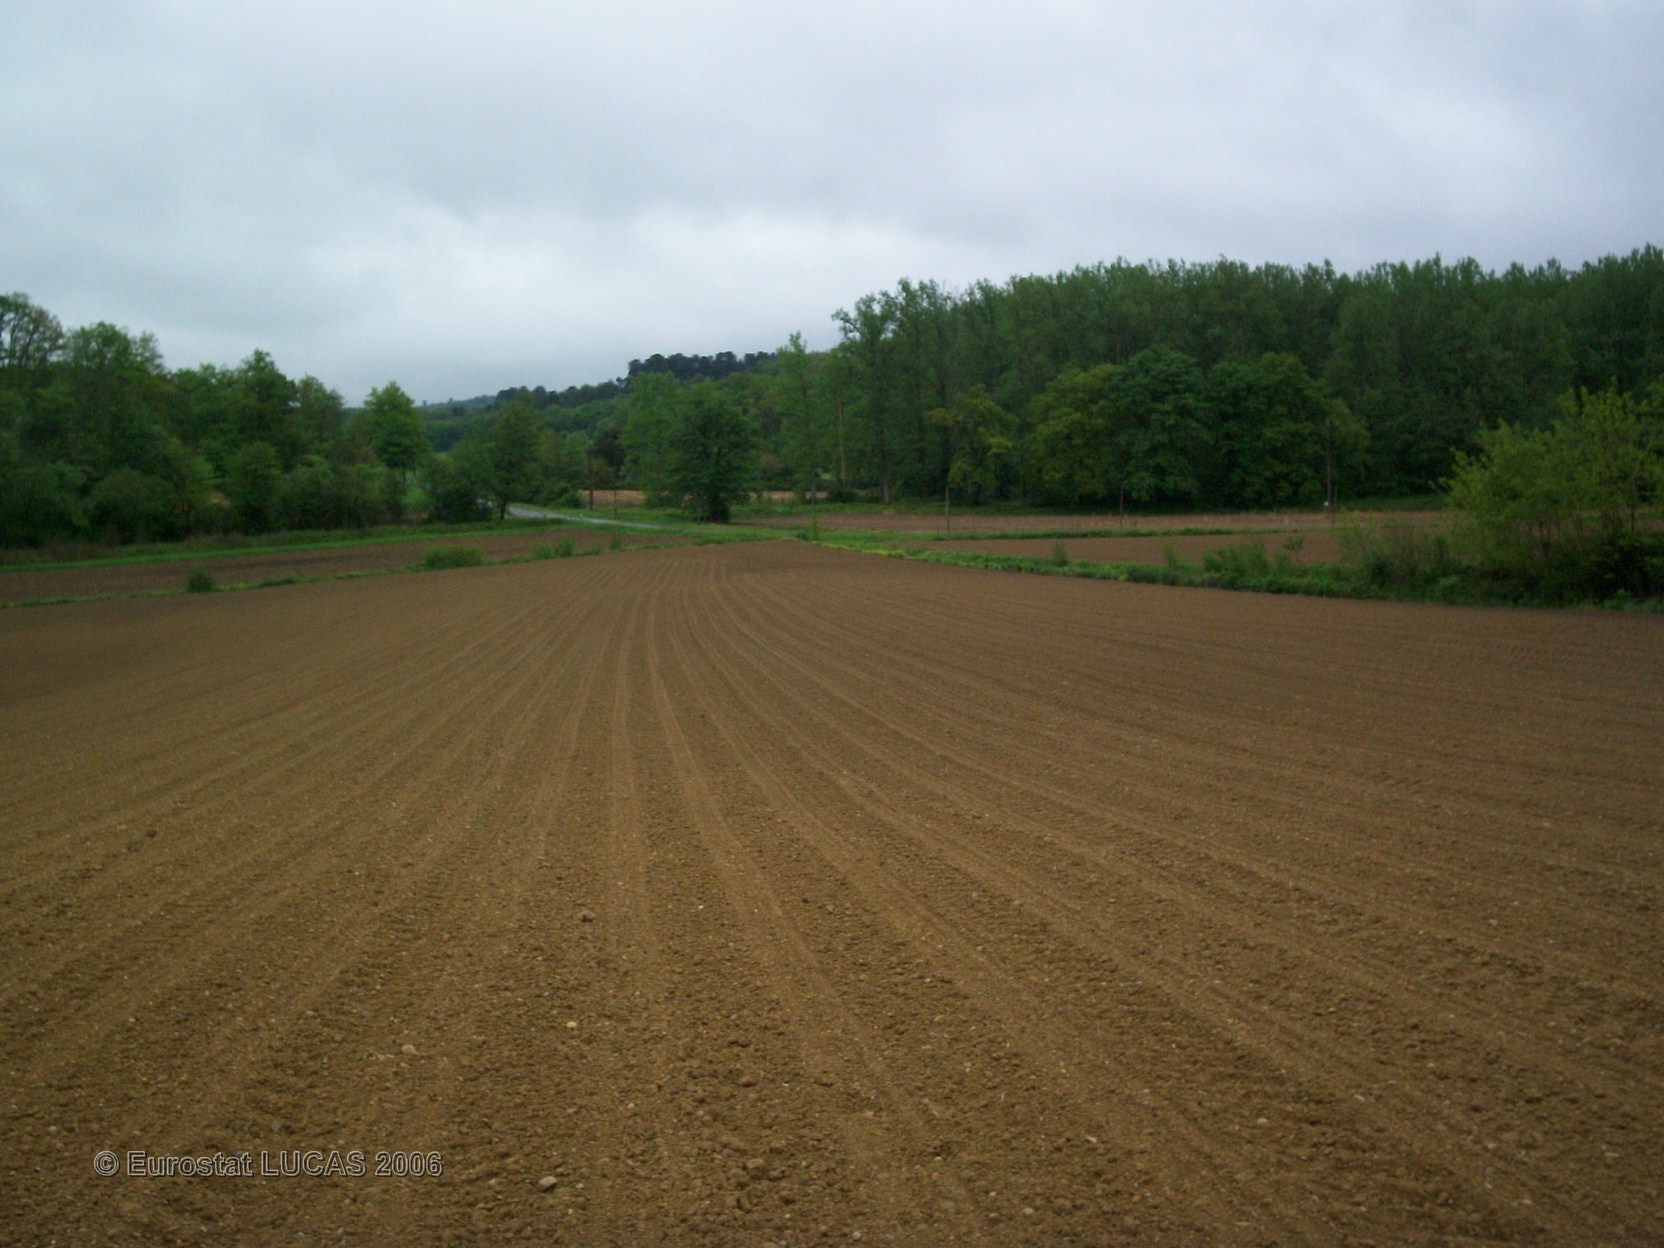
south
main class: Cropland
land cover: Maize
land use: Agriculture (excluding fallow land and kitchen gardens)
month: April
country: FR
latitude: 43.6488
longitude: -0.3614
